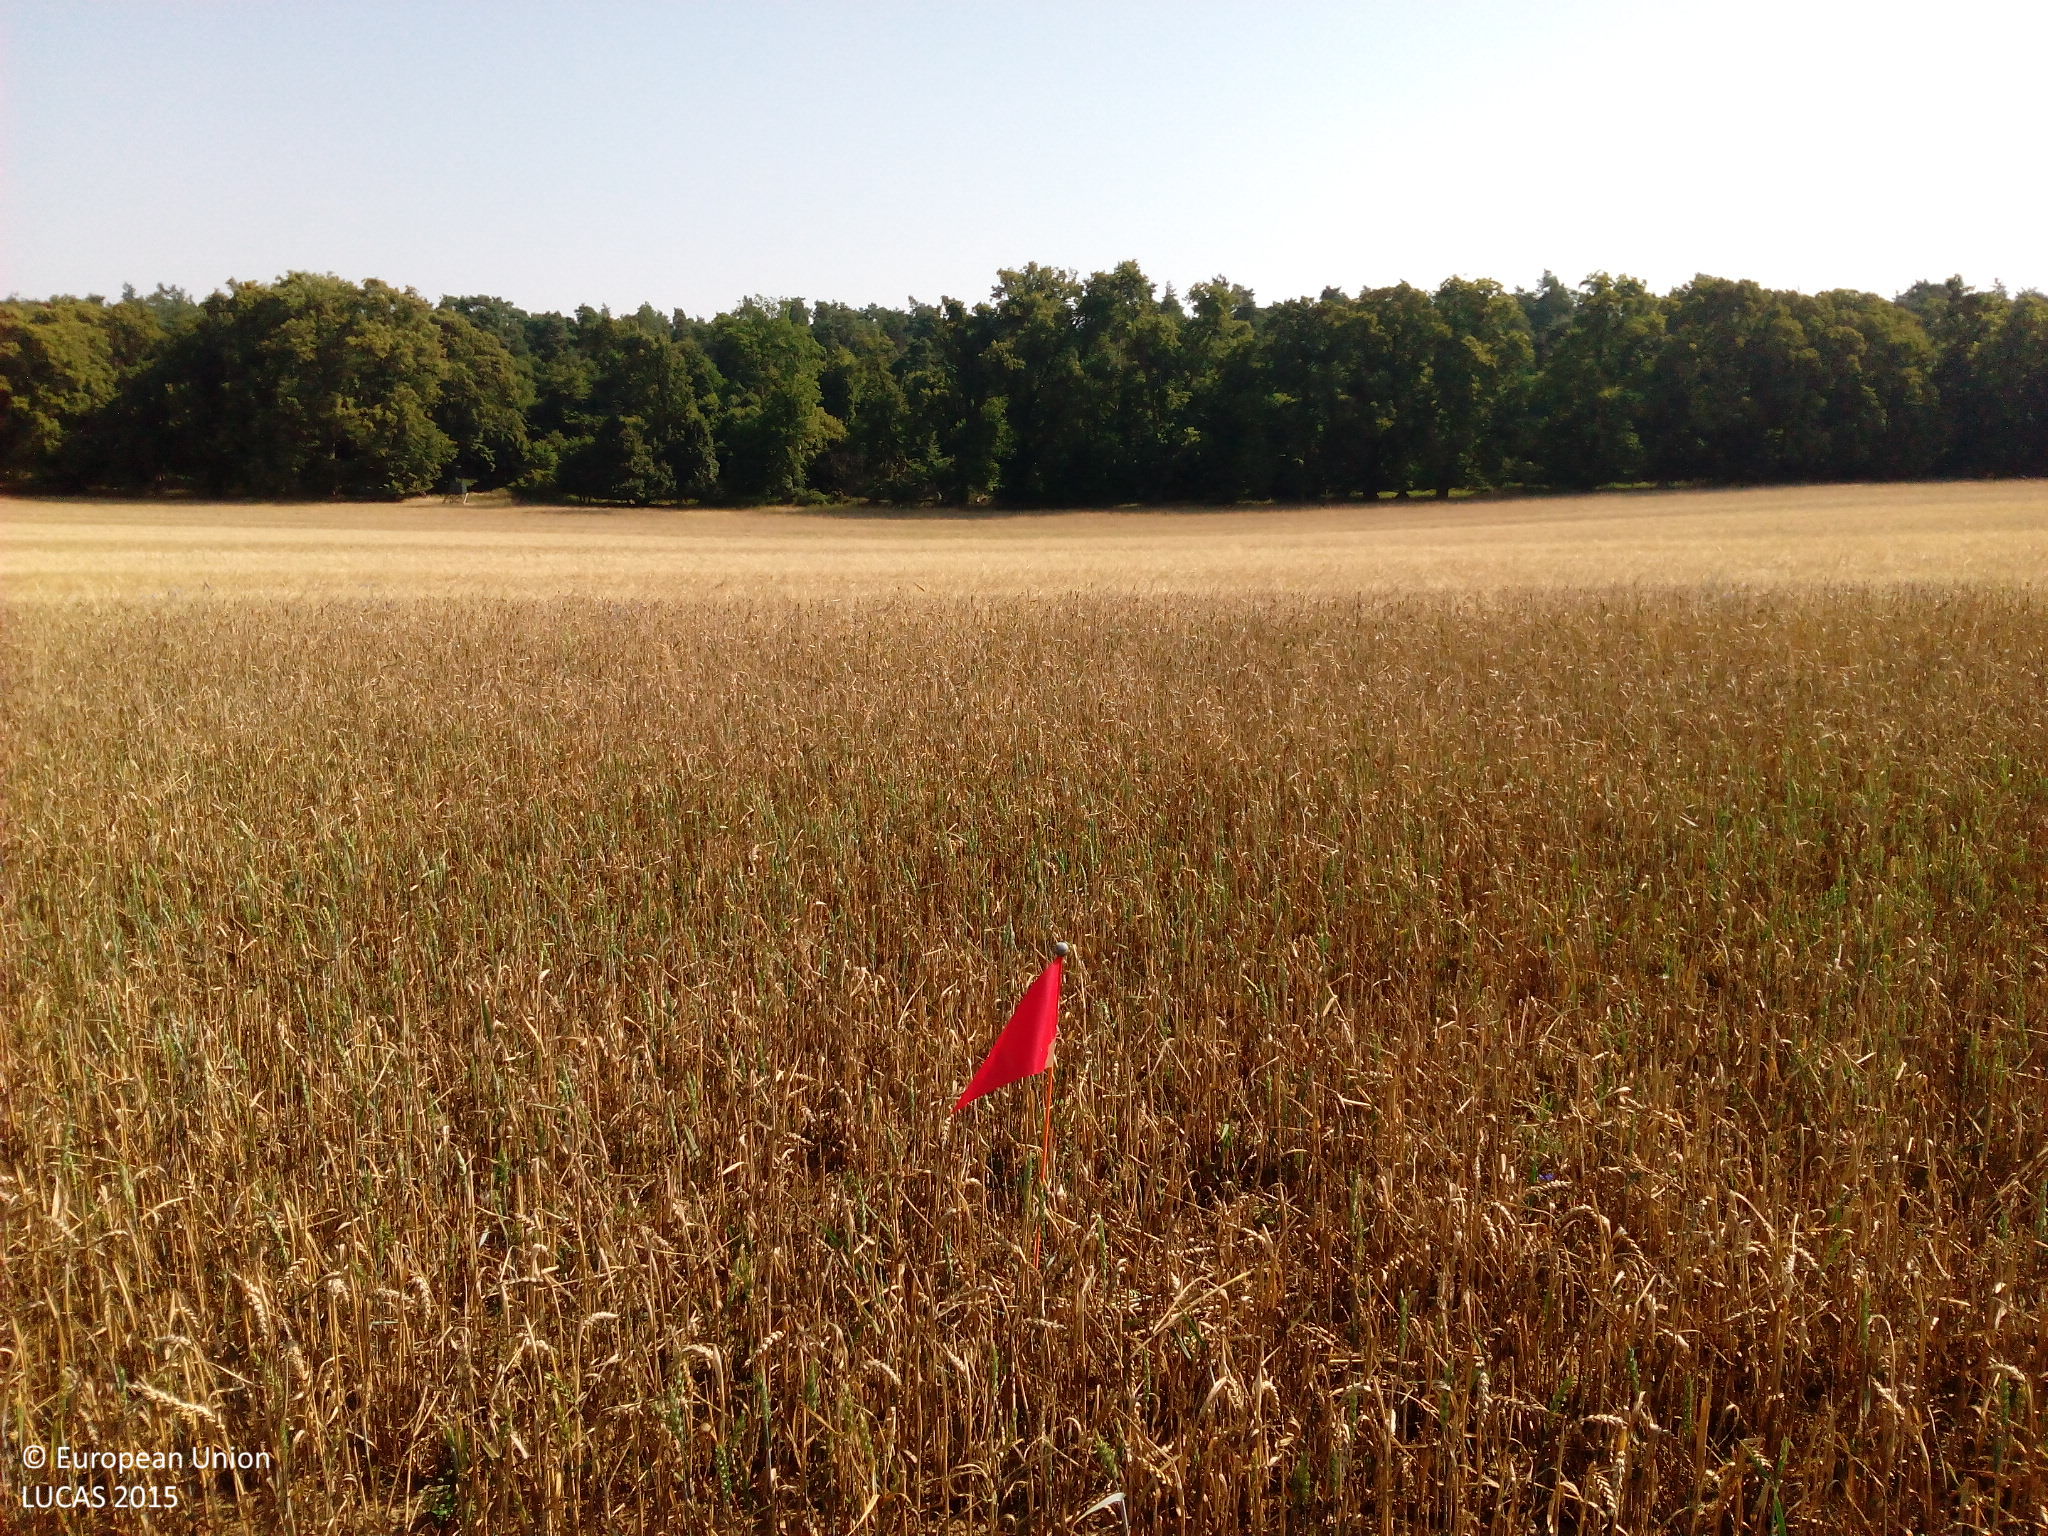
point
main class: Cropland
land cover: Common wheat
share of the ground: 25 - 50 %
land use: Agriculture (excluding fallow land and kitchen gardens)
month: August
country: DE
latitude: 53.2949
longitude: 13.5857
